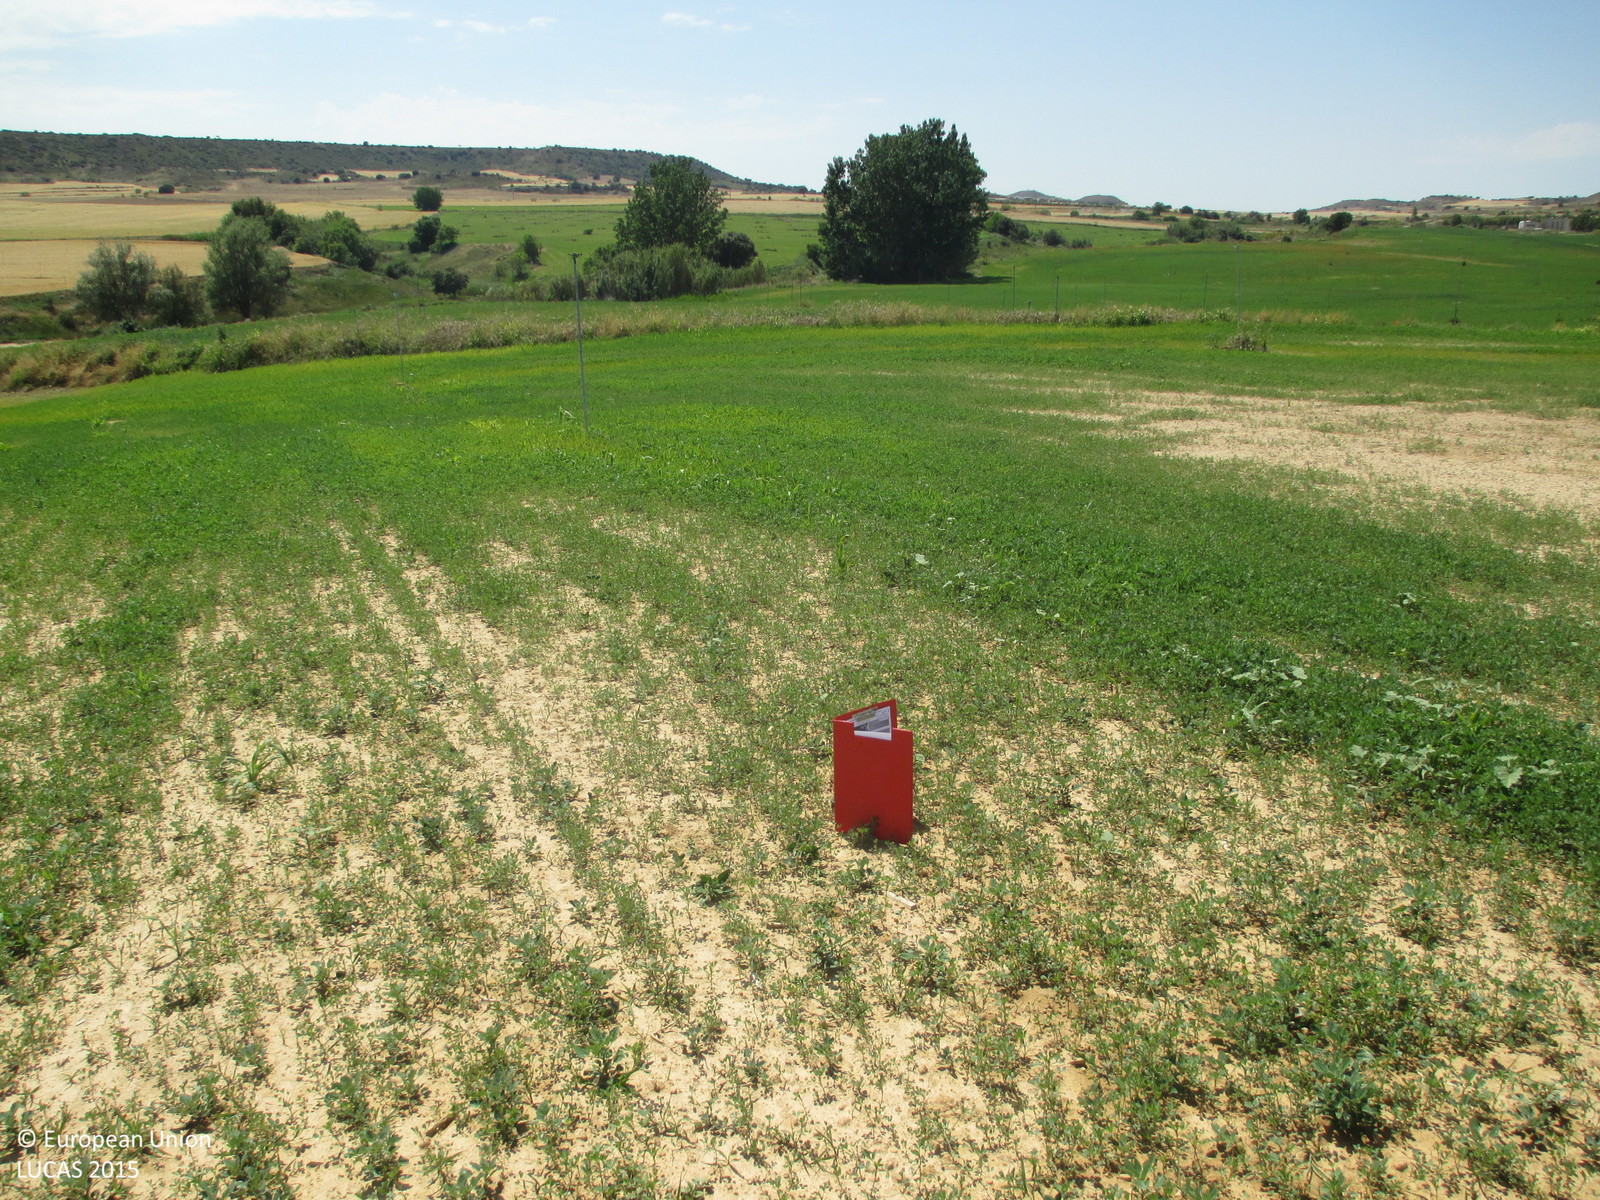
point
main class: Cropland
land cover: Lucerne
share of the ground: > 75 %
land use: Agriculture (excluding fallow land and kitchen gardens)
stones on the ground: < 10 %
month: May
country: ES
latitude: 41.9390
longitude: -0.1871
